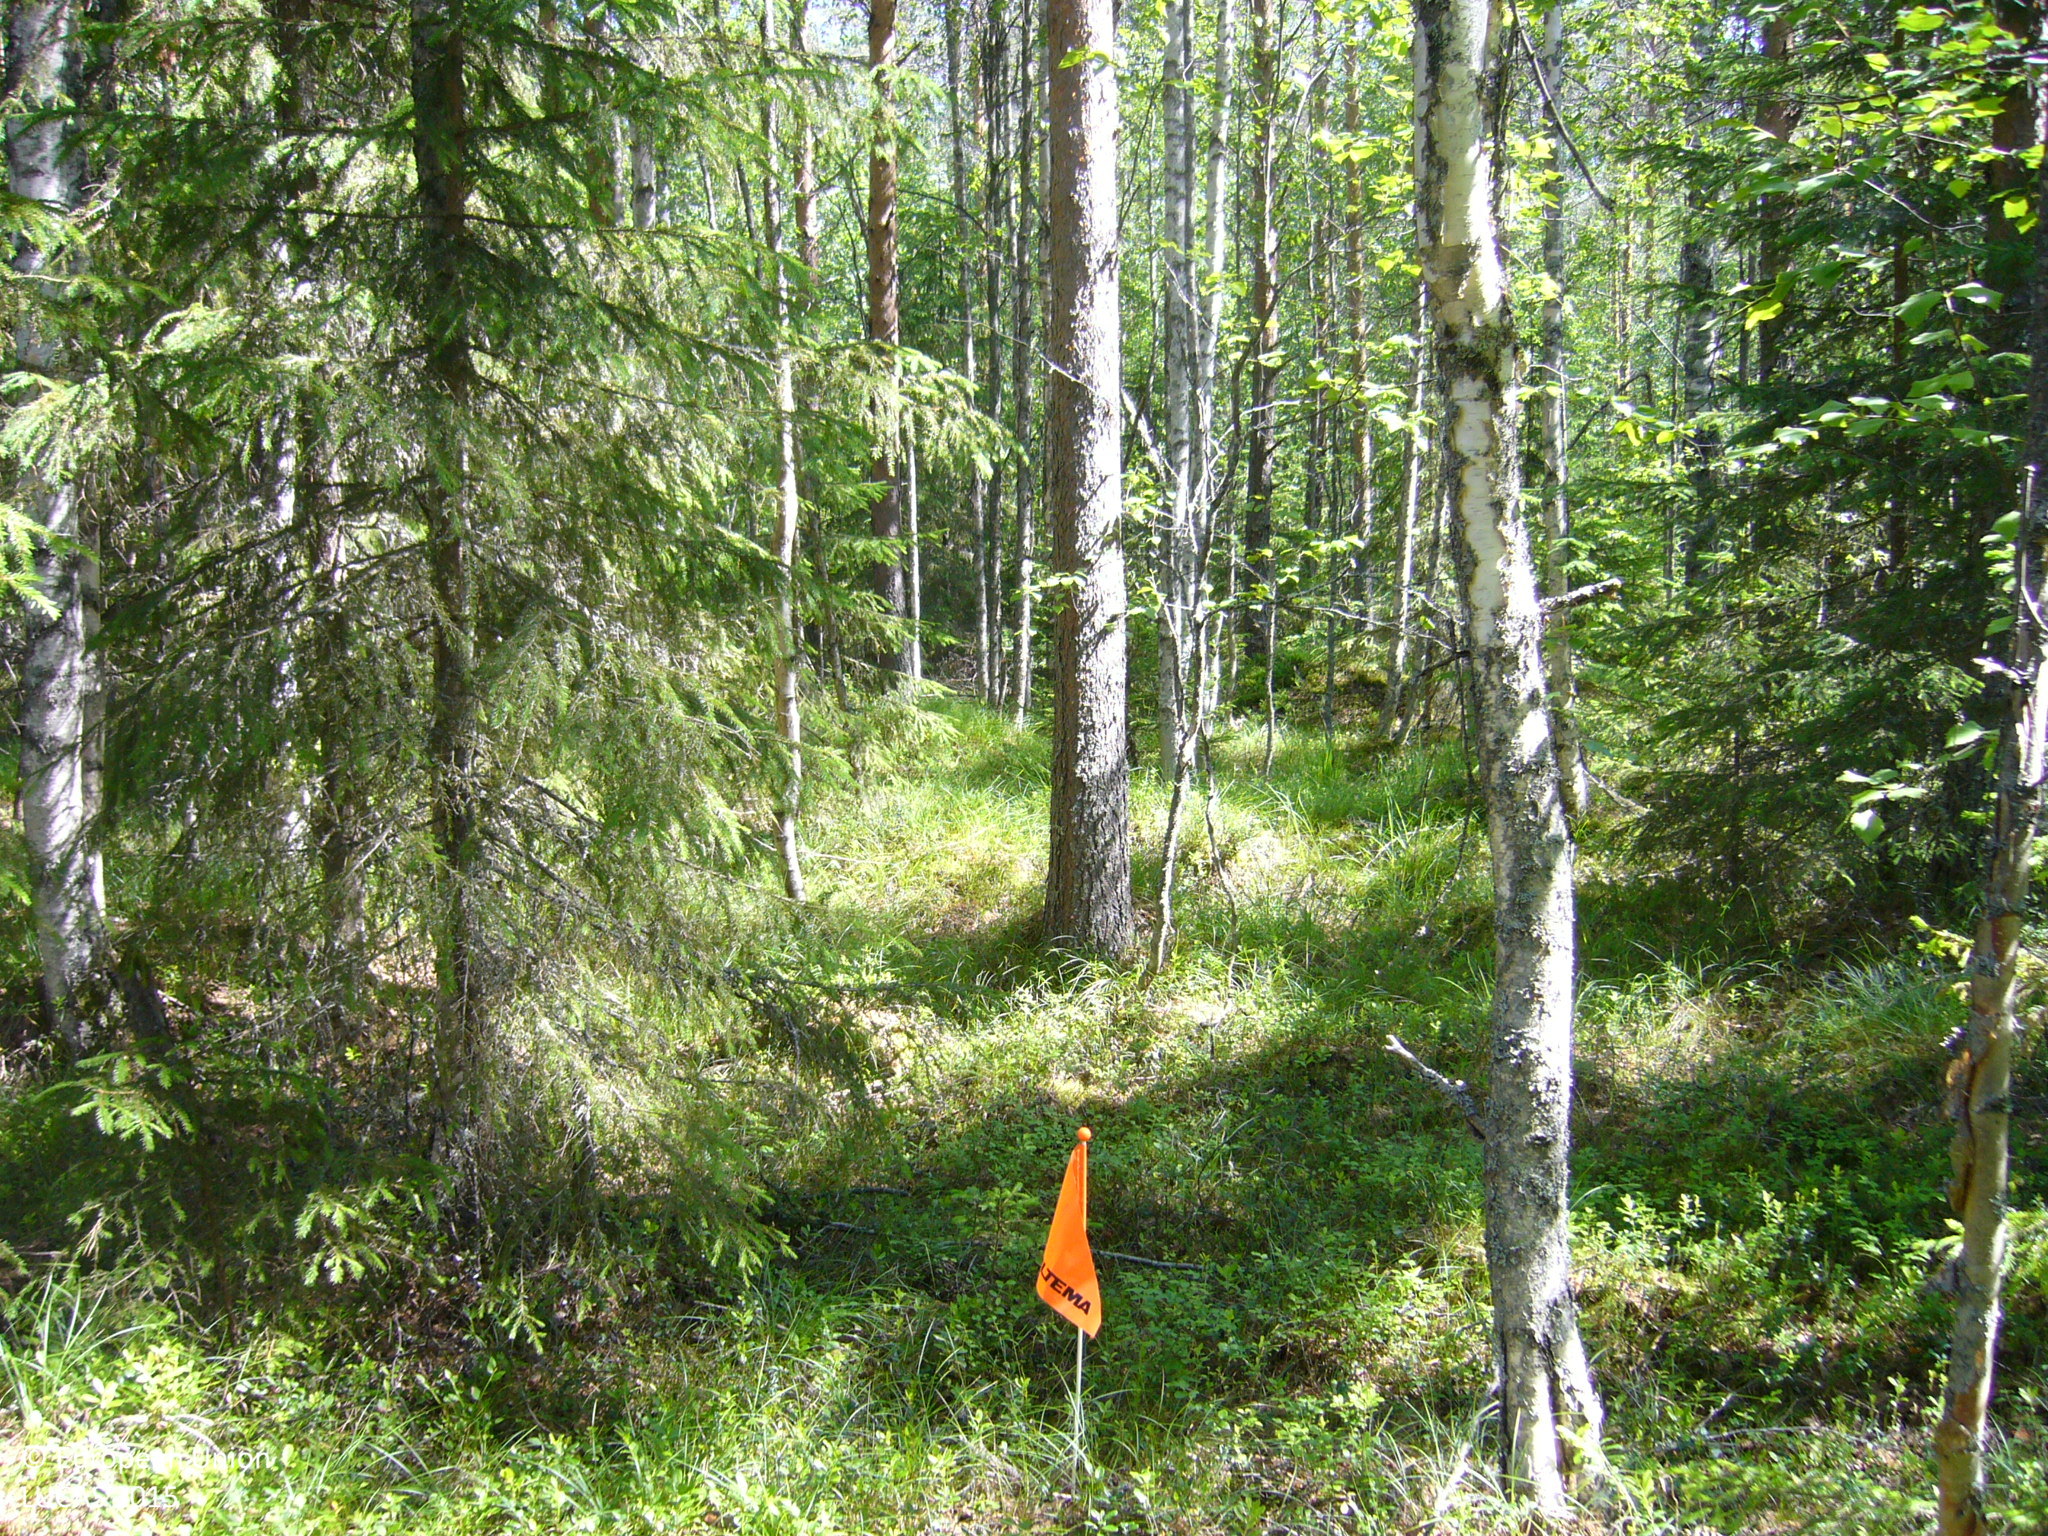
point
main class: Woodland
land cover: Pine dominated coniferous woodland
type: boreal forest
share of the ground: > 75 %
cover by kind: coniferous forest trees 60 %, shrubs 25 %, broadleaved forest trees 15 %
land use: Forestry
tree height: > 5 m
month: July
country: FI
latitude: 63.3895
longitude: 25.8596
